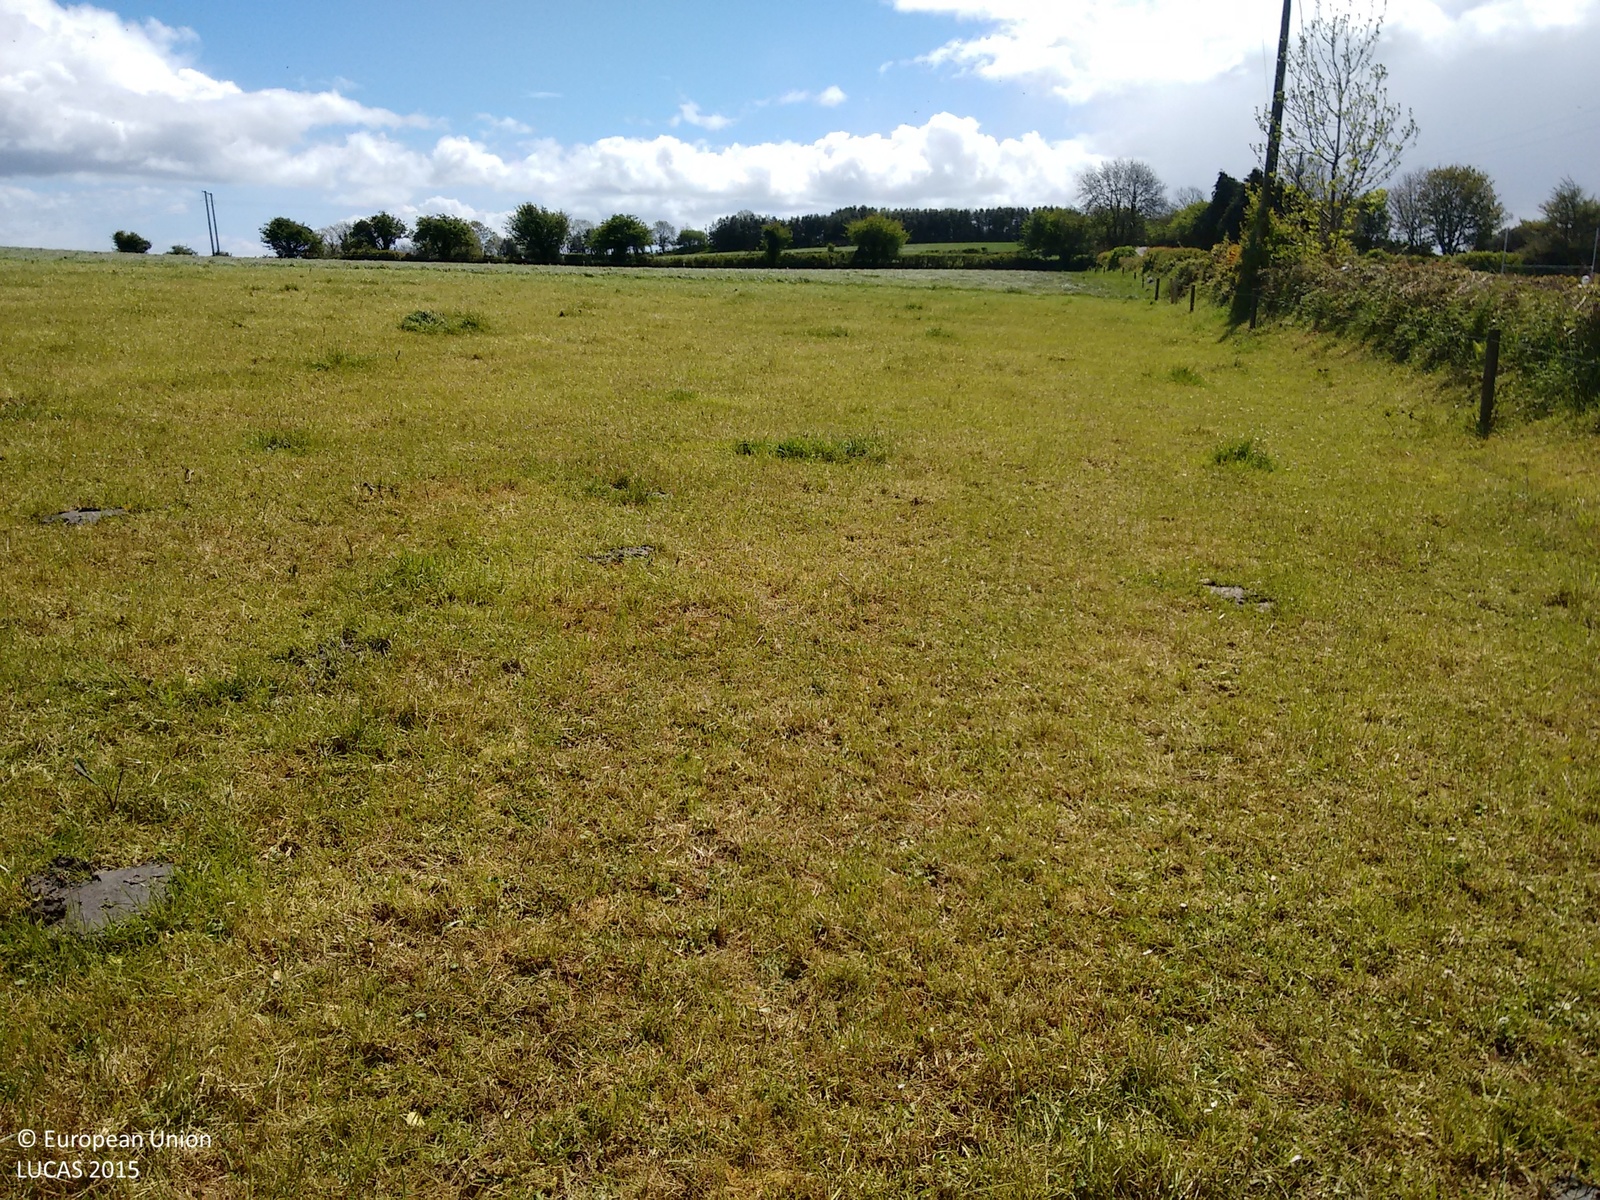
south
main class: Grassland
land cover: Grassland without tree/shrub cover
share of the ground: > 75 %
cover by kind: herbaceous plants 95 %, shrubs 5 %
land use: Agriculture (excluding fallow land and kitchen gardens)
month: May
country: IE
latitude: 51.9301
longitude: -8.3228
